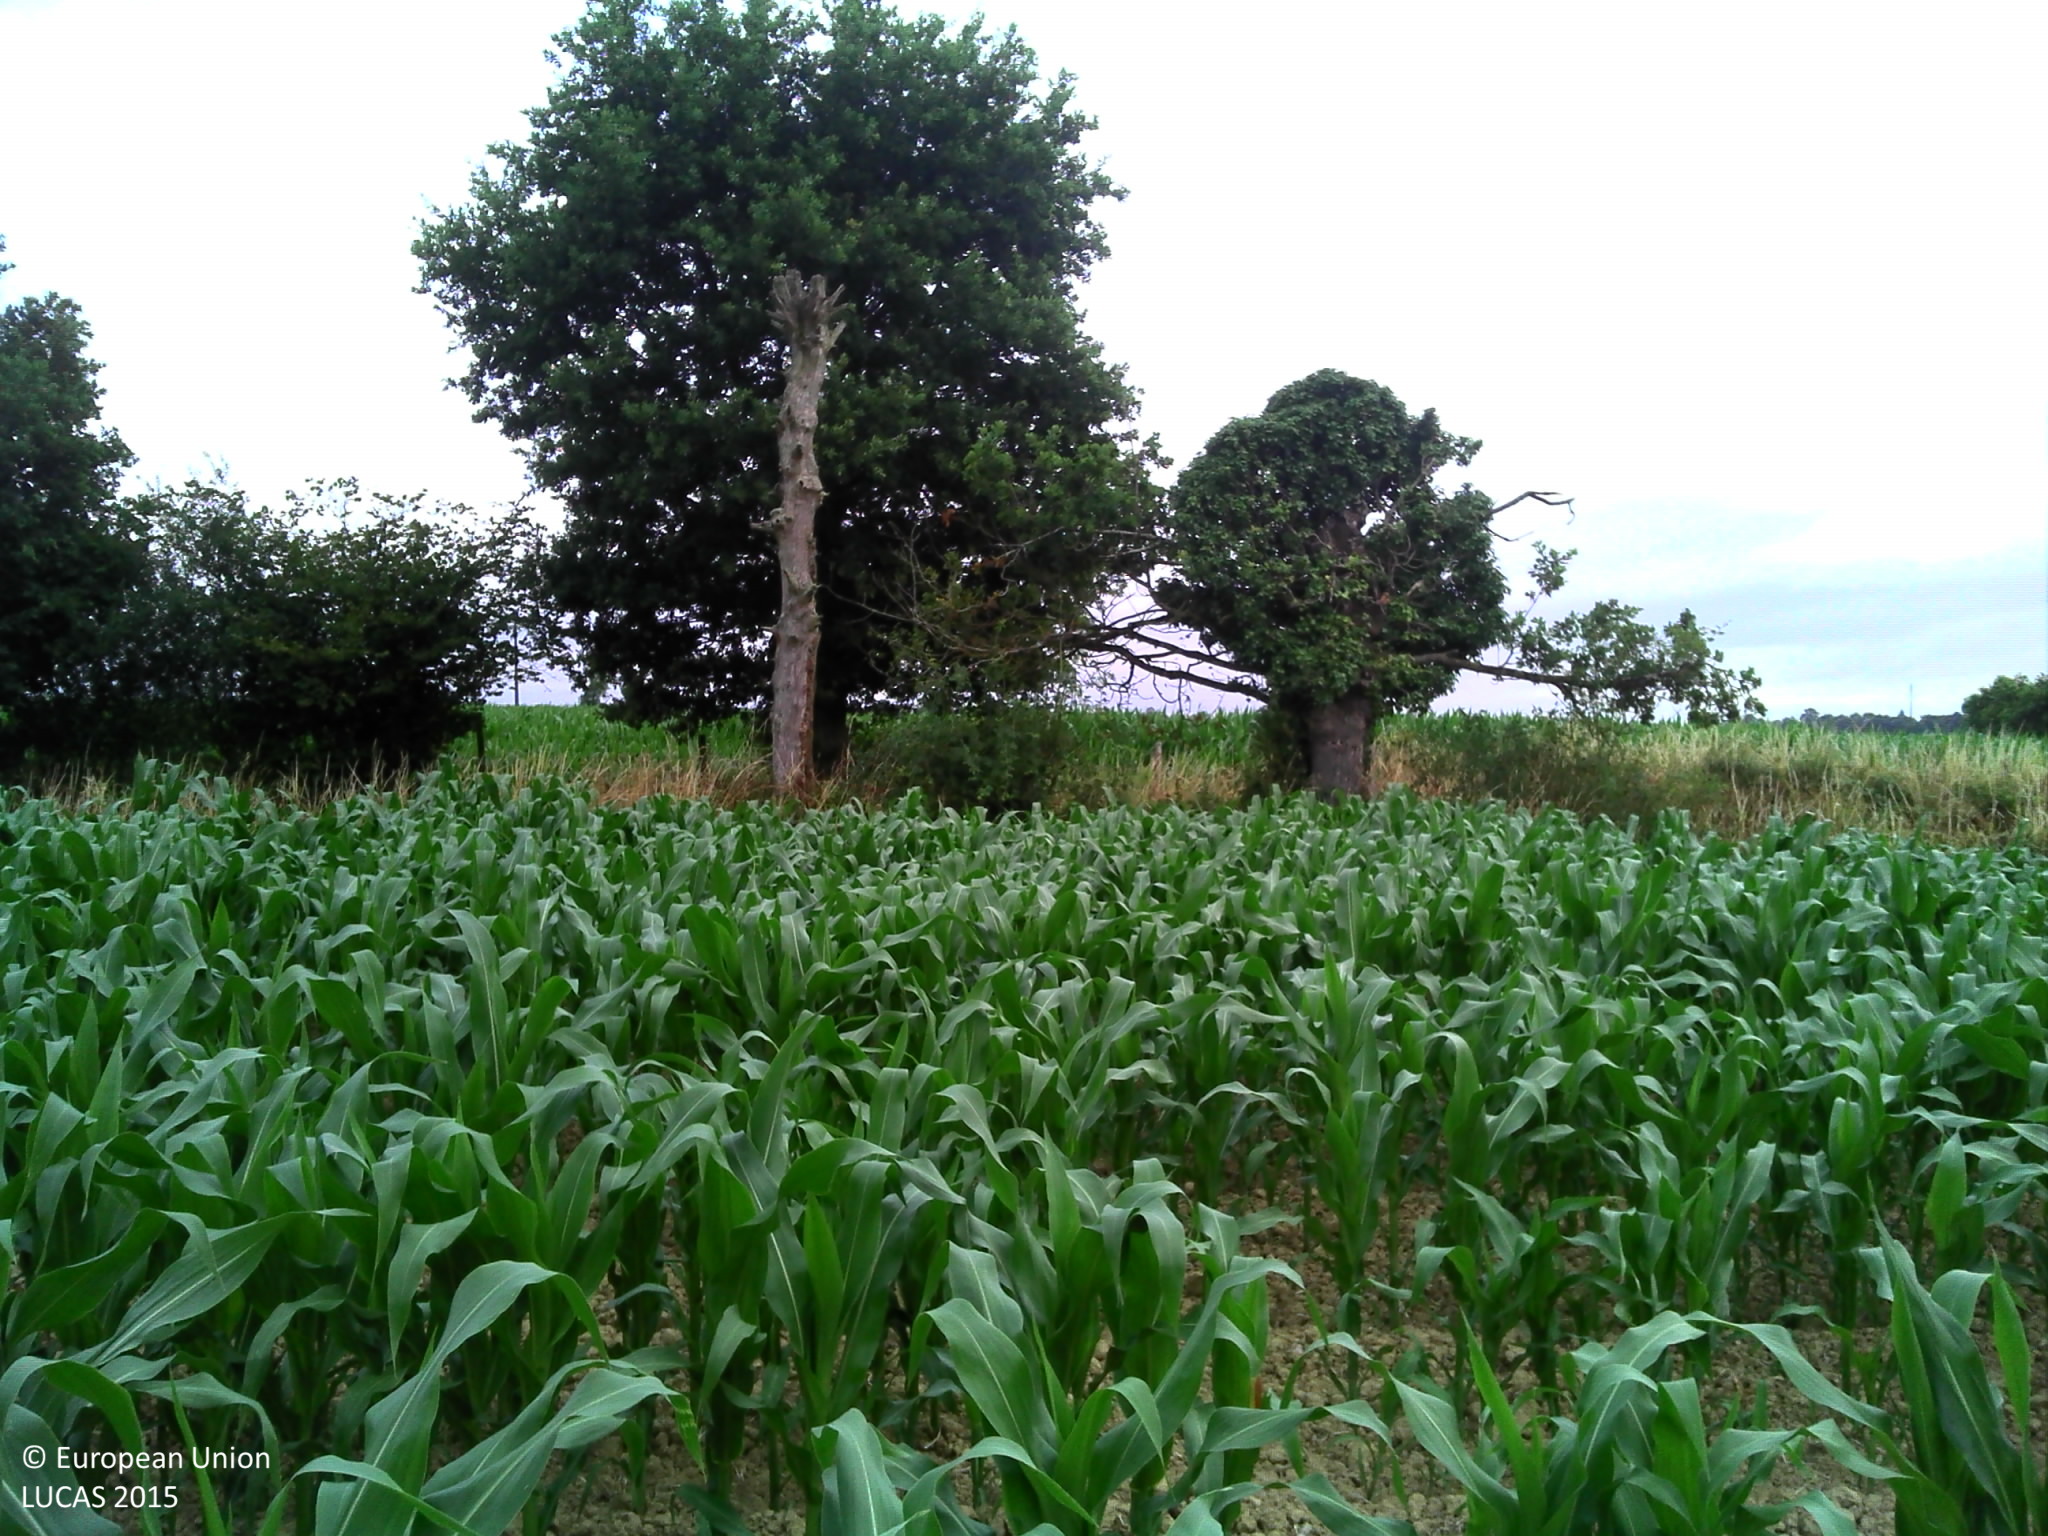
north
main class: Cropland
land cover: Maize
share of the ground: 25 - 50 %
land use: Agriculture (excluding fallow land and kitchen gardens)
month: July
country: FR
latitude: 47.8465
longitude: -1.4153
